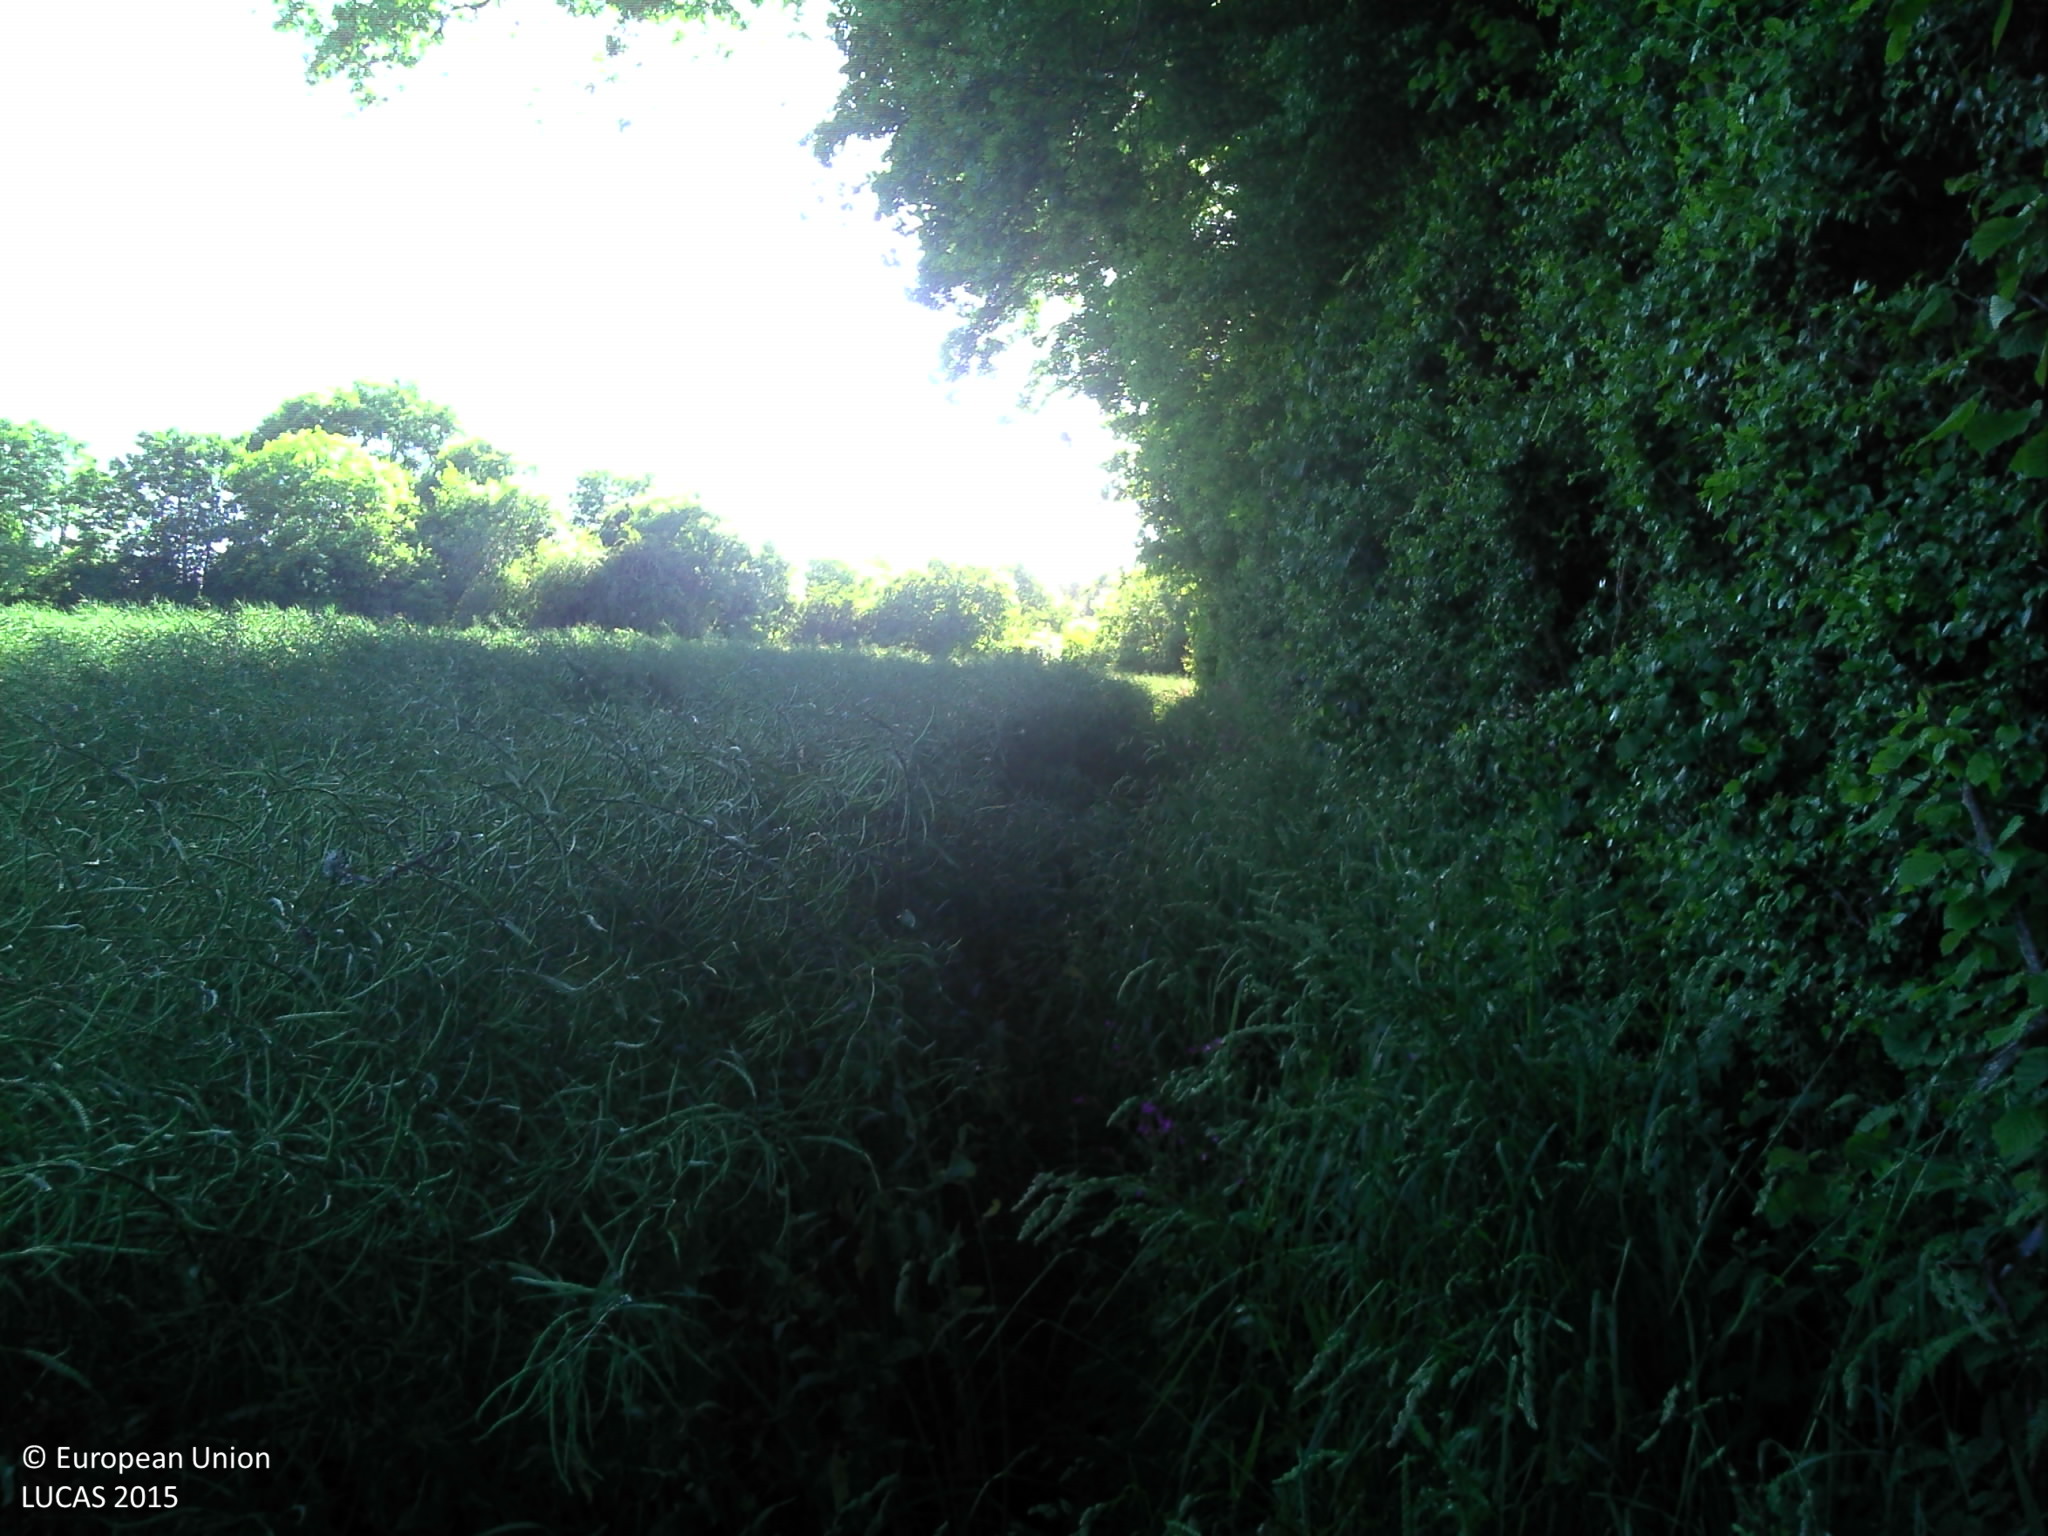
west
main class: Cropland
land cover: Rape and turnip rape
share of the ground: > 75 %
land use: Agriculture (excluding fallow land and kitchen gardens)
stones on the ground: < 10 %
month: June
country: FR
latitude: 49.4988
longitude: -1.7760
